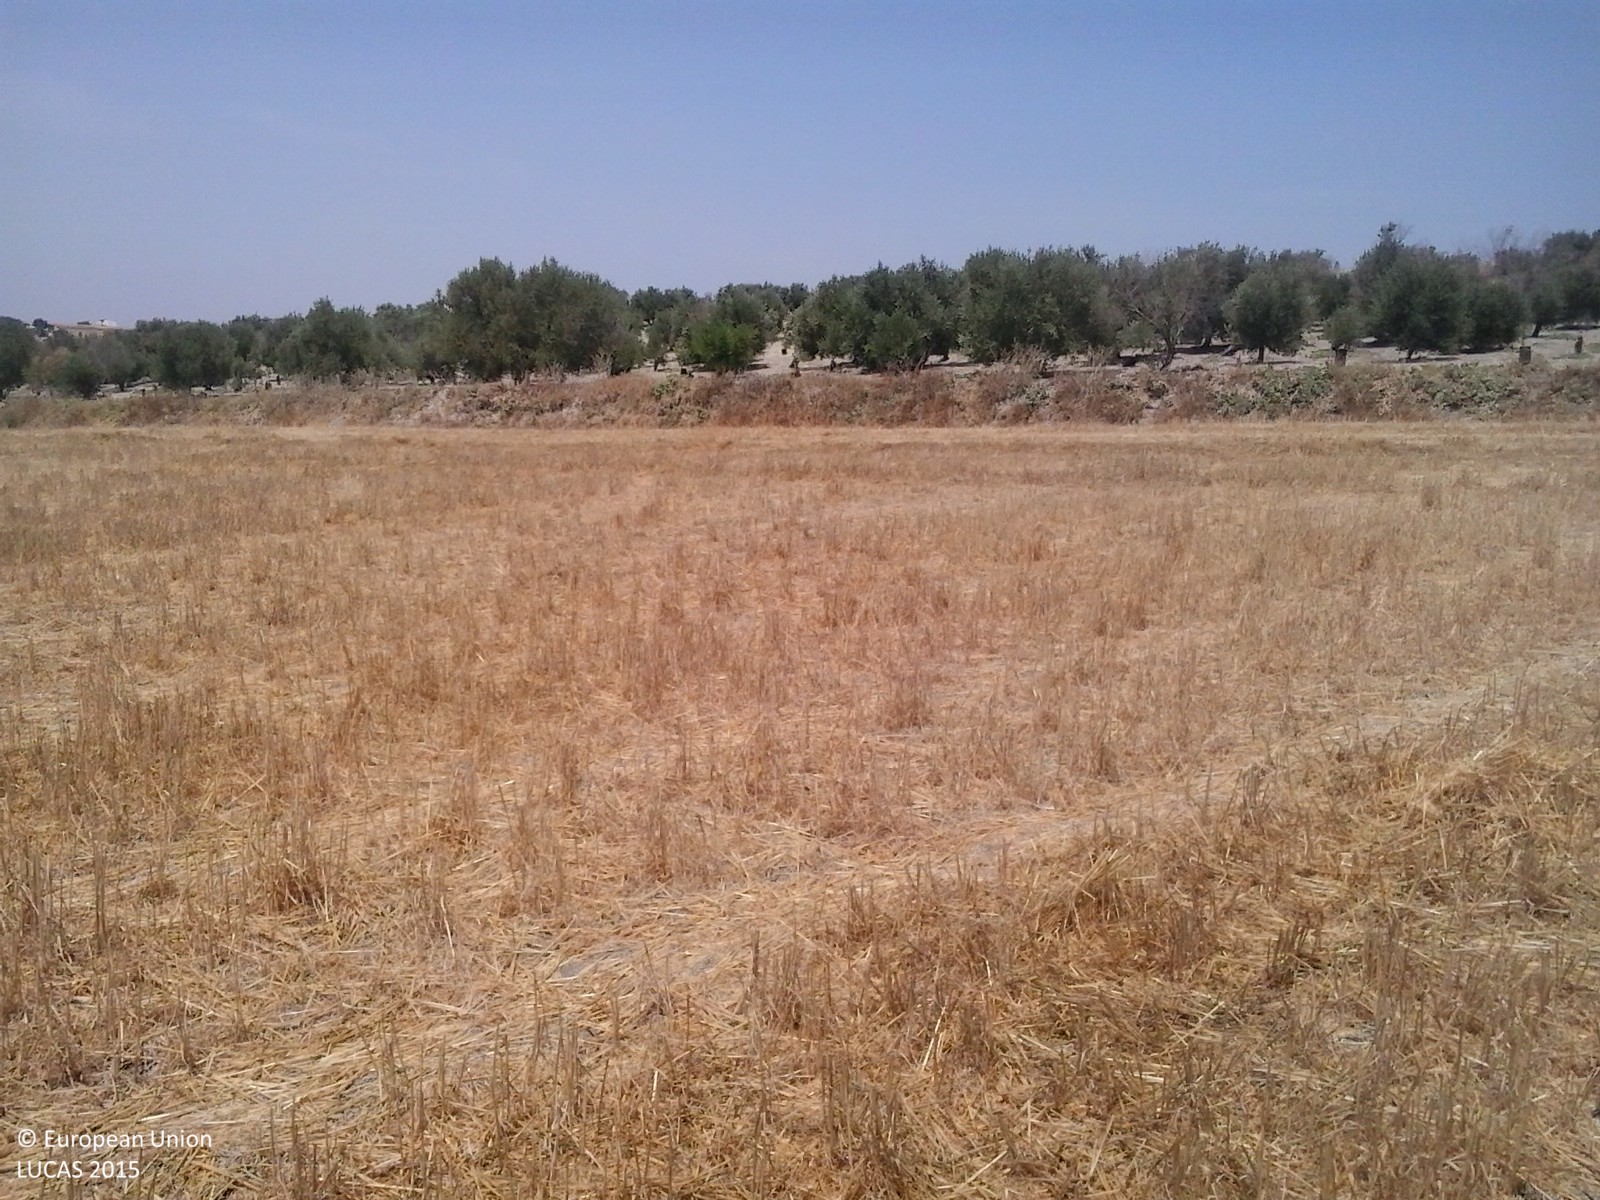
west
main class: Cropland
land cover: Common wheat
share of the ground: < 10 %
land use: Agriculture (excluding fallow land and kitchen gardens)
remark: Harvested field
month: July
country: ES
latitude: 36.9341
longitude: -6.0142
